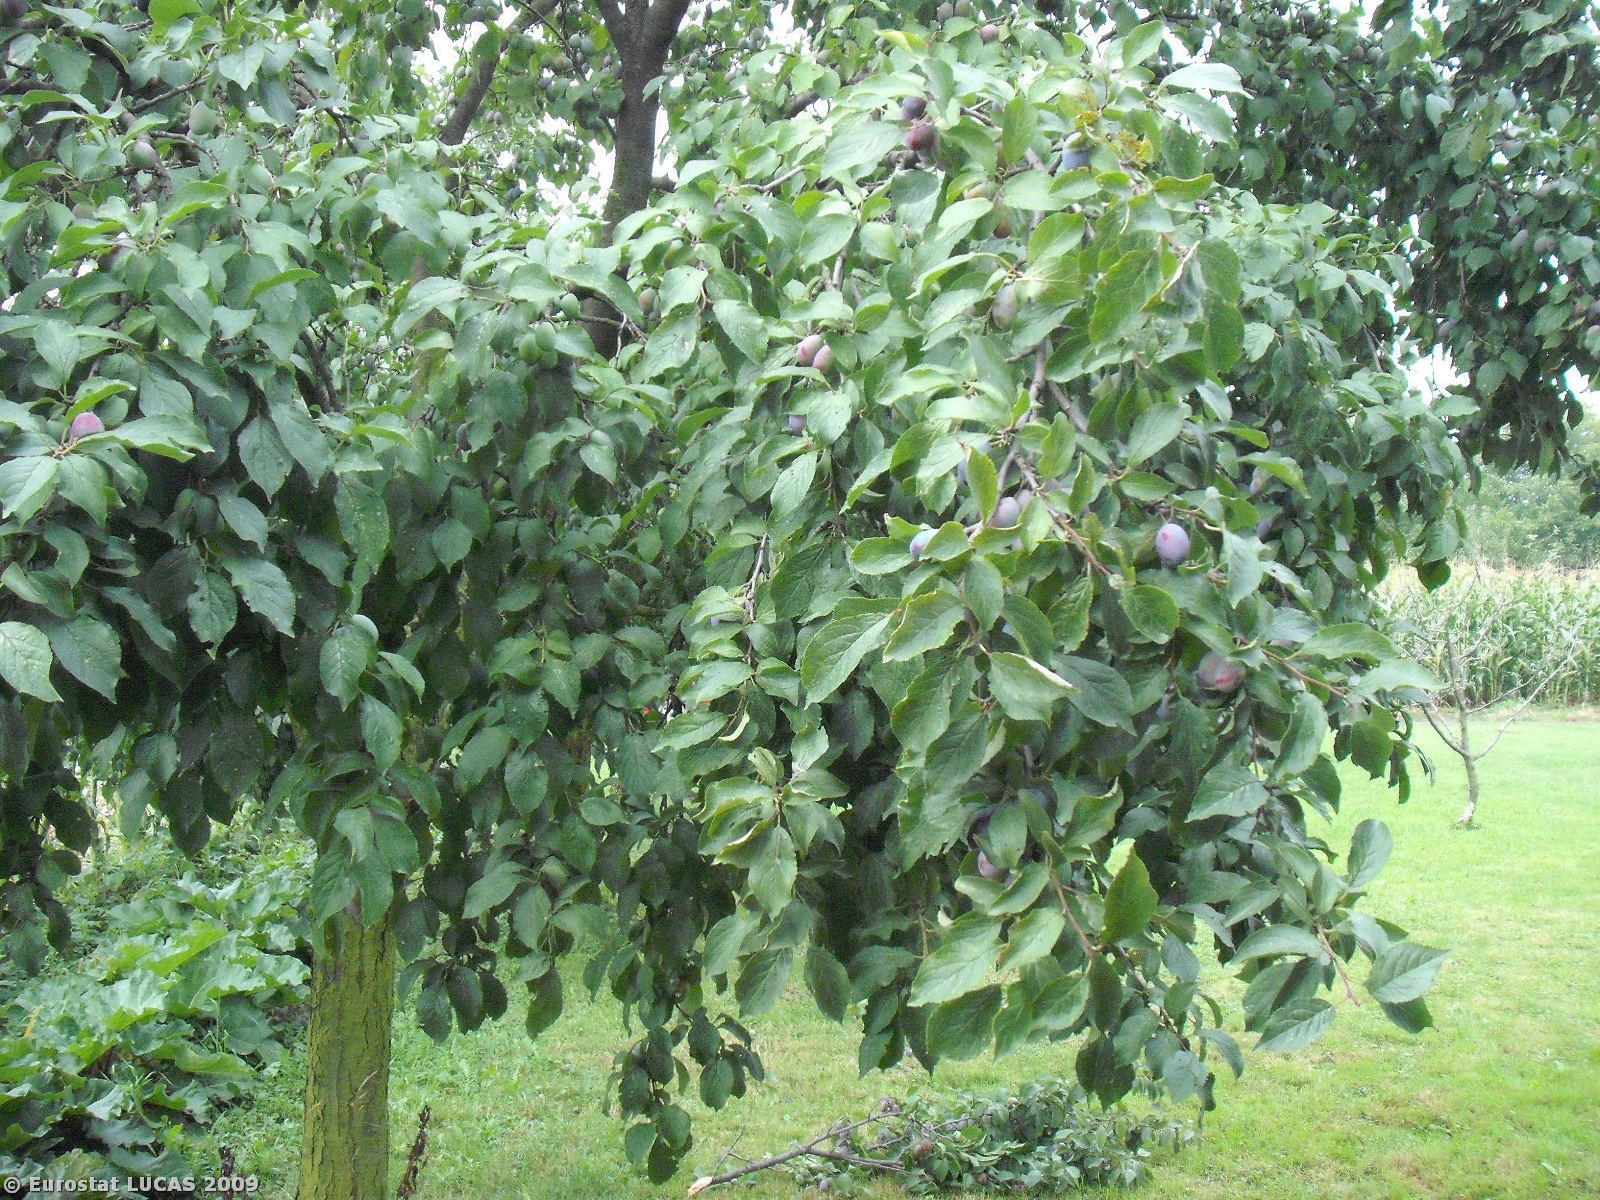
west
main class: Cropland
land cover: Other fruit trees and berries
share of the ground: > 75 %
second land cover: Grassland with sparse tree/shrub cover
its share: > 75 %
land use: Kitchen garden
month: August
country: PL
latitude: 50.0292
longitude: 22.5885
